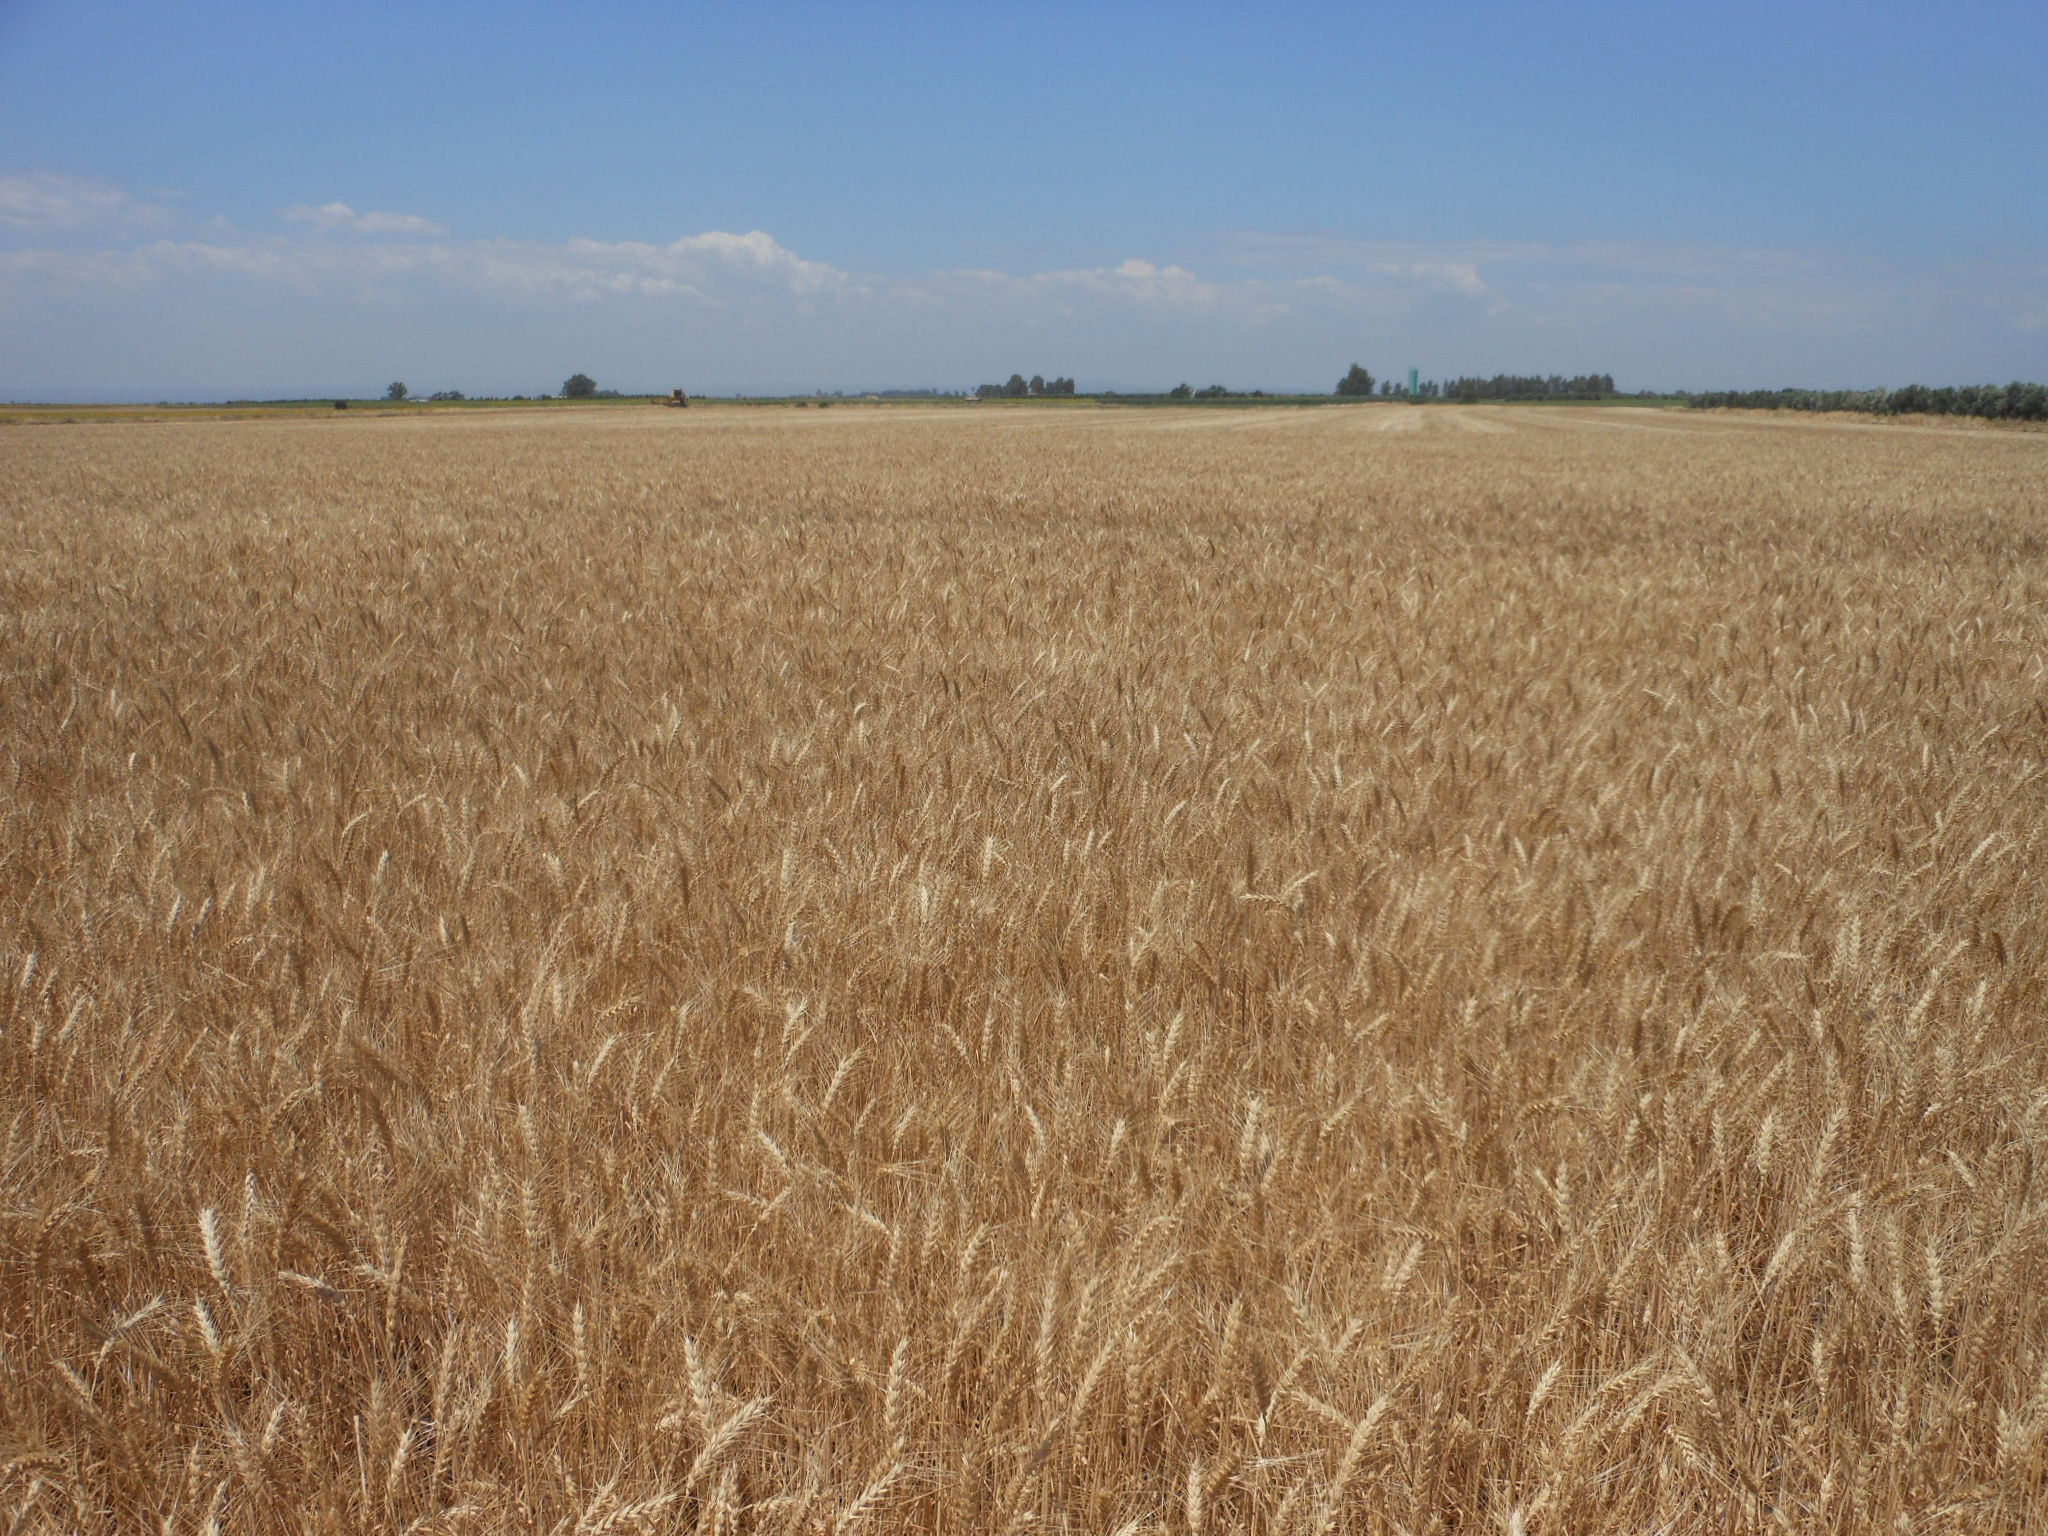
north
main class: Cropland
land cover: Common wheat
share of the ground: > 75 %
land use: Agriculture (excluding fallow land and kitchen gardens)
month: May
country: ES
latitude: 37.4961
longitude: -5.4108
